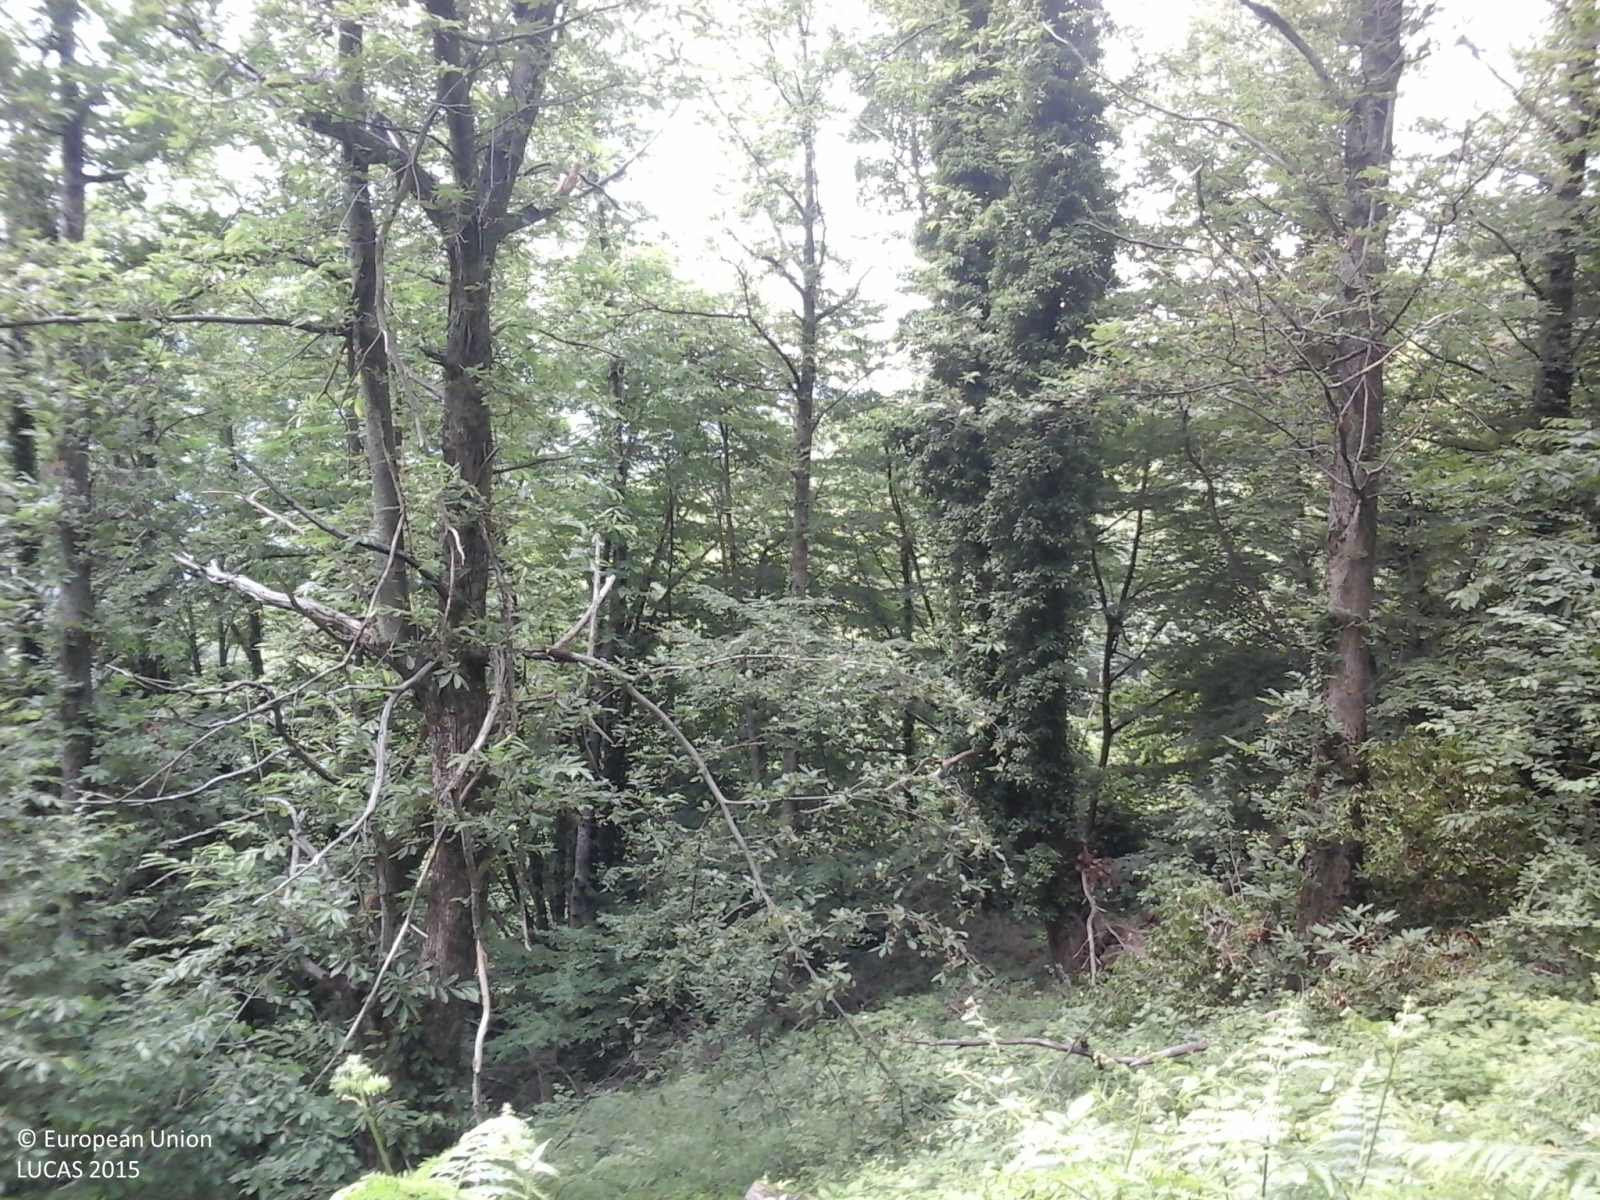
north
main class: Woodland
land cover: Broadleaved woodland
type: thermophilous deciduous forest
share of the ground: > 75 %
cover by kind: broadleaved forest trees 100 %
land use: Forestry
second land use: Other primary production
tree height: > 5 m
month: June
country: IT
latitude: 42.8334
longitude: 13.3546
